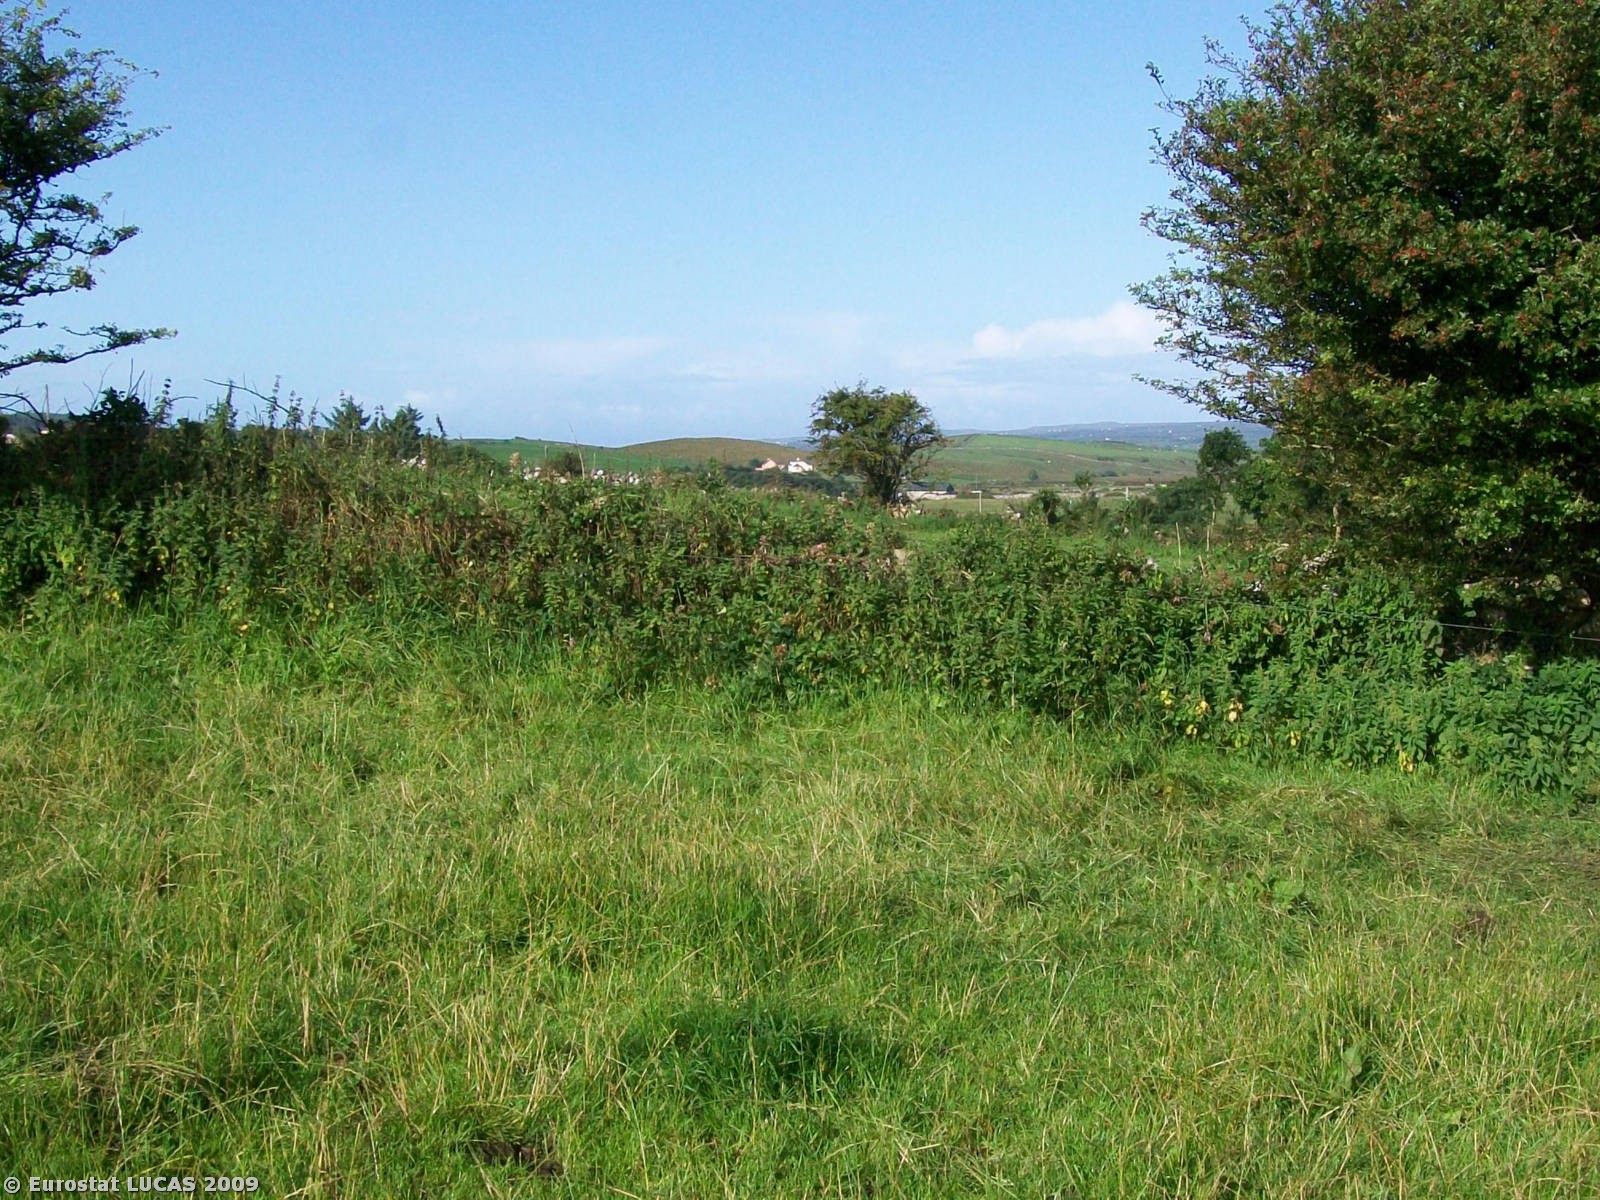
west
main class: Grassland
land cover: Grassland without tree/shrub cover
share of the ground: > 75 %
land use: Agriculture (excluding fallow land and kitchen gardens)
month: August
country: IE
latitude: 52.9890
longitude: -9.2148
